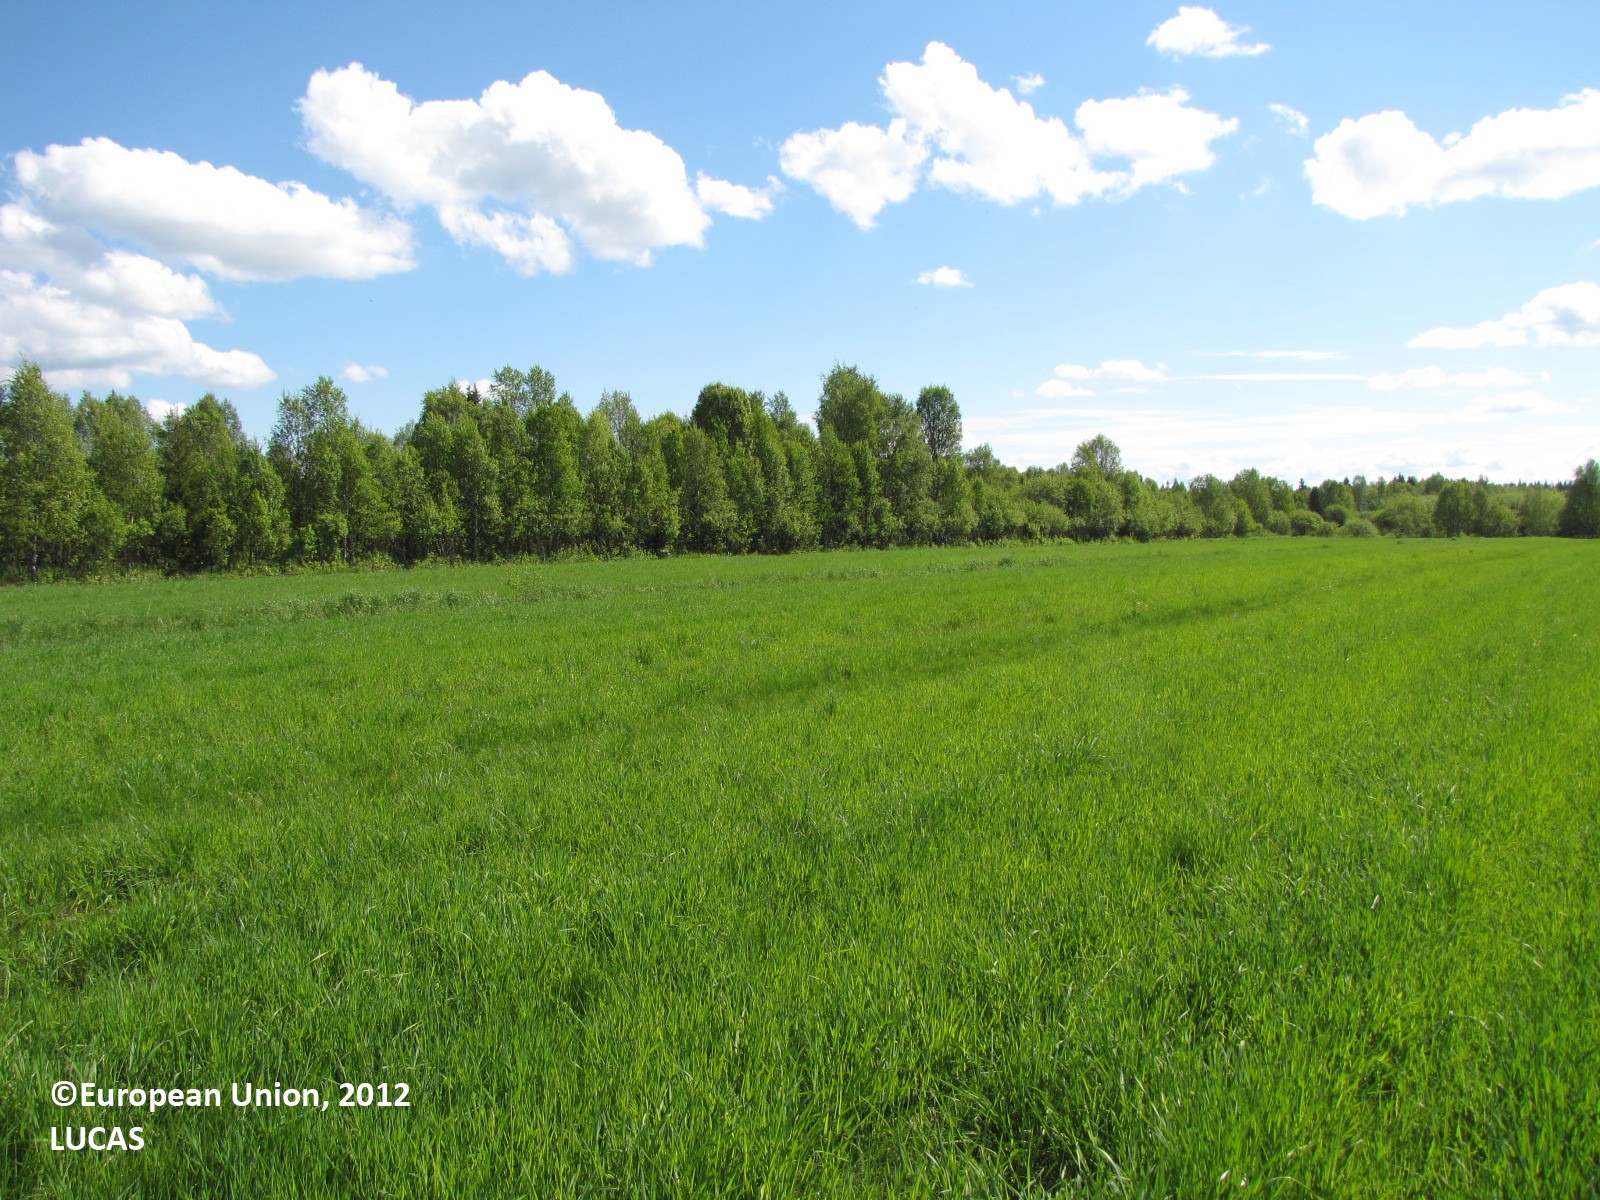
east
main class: Grassland
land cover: Grassland without tree/shrub cover
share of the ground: > 75 %
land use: Agriculture (excluding fallow land and kitchen gardens)
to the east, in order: Grassland without tree/shrub cover; Ditches and canals; Grassland without tree/shrub cover; Ditches and canals; Abandoned hedges; Grassland with sparse tree/shrub cover; Ditches and canals; Grassland with sparse tree/shrub cover; Ditches and canals; Broadleaved woodland; Ditches and canals; Broadleaved woodland; Ditches and canals; Other mixed woodland; Ditches and canals; Other mixed woodland; Ditches and canals; Shruby margins; Paved roads, cycling and walking lanes; Grass margins; Ditches and canals; Grassland without tree/shrub cover
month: June
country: FI
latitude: 66.0108
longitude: 24.7582
